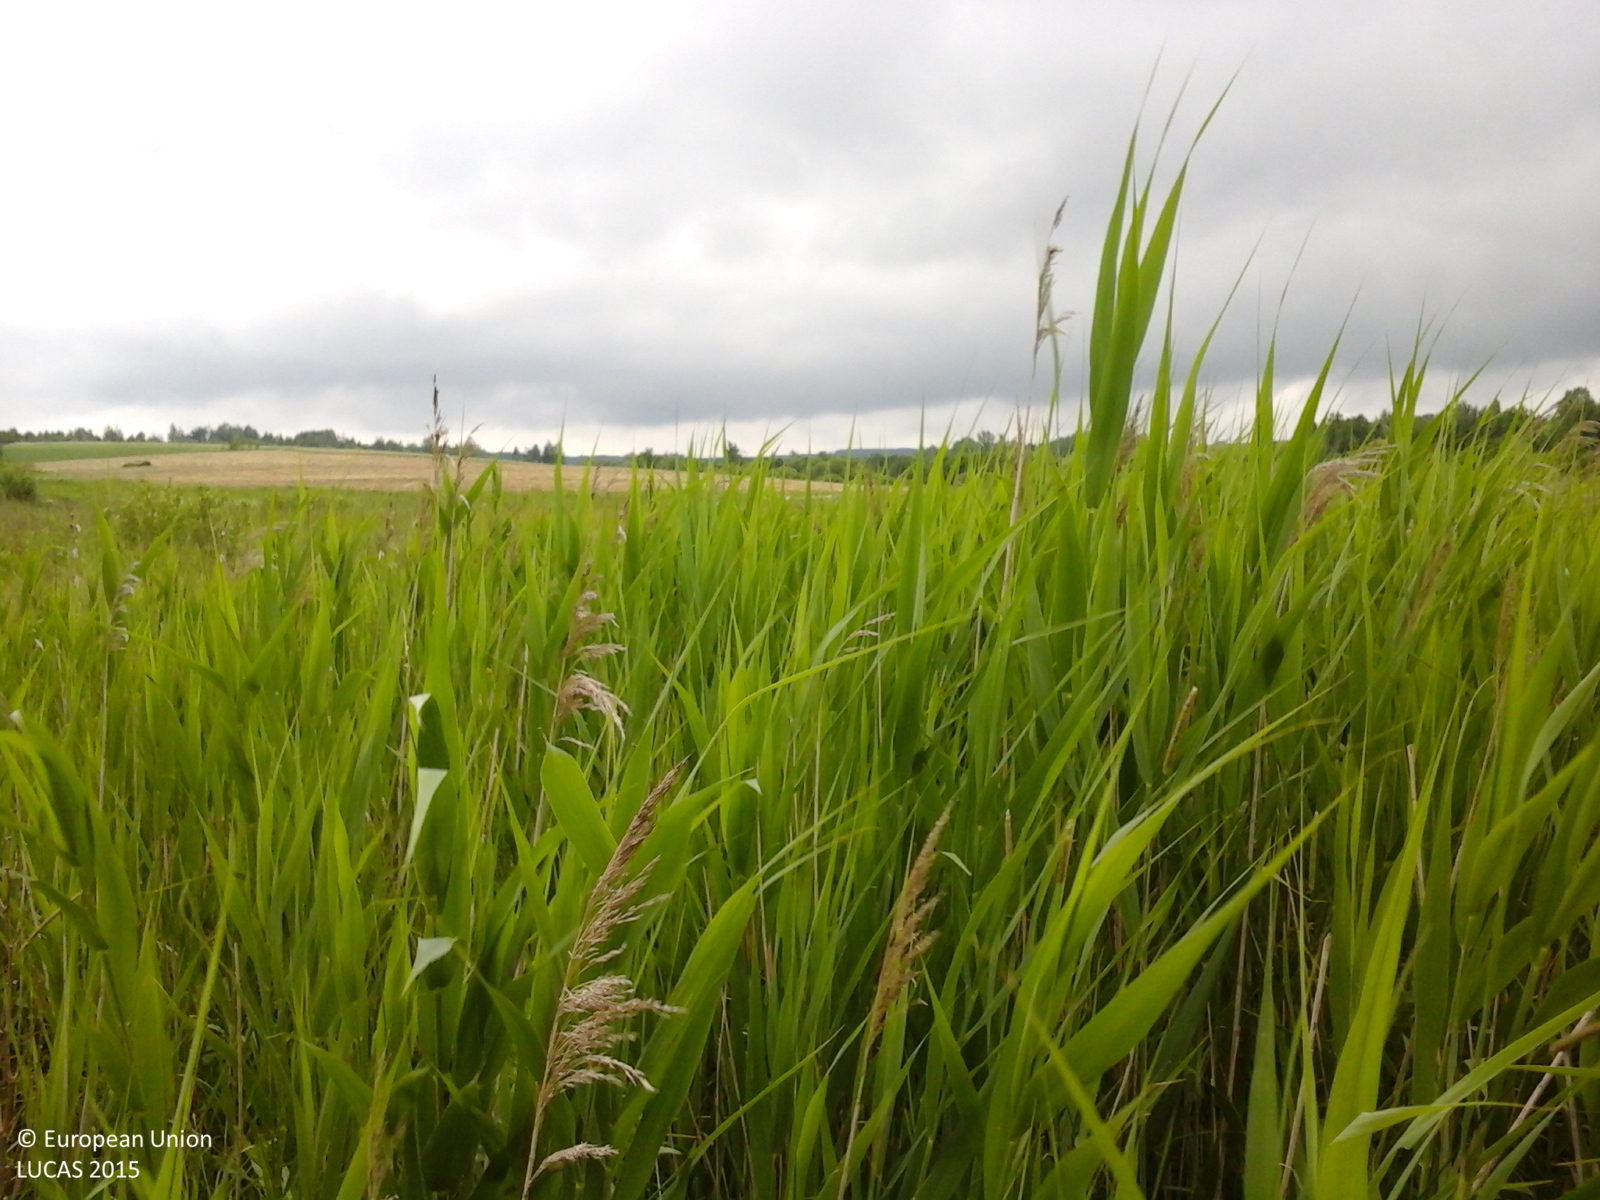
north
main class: Grassland
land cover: Spontaneously vegetated surfaces
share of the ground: > 75 %
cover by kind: herbaceous plants 100 %
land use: Fallow land
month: June
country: RO
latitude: 47.9634
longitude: 25.8654
